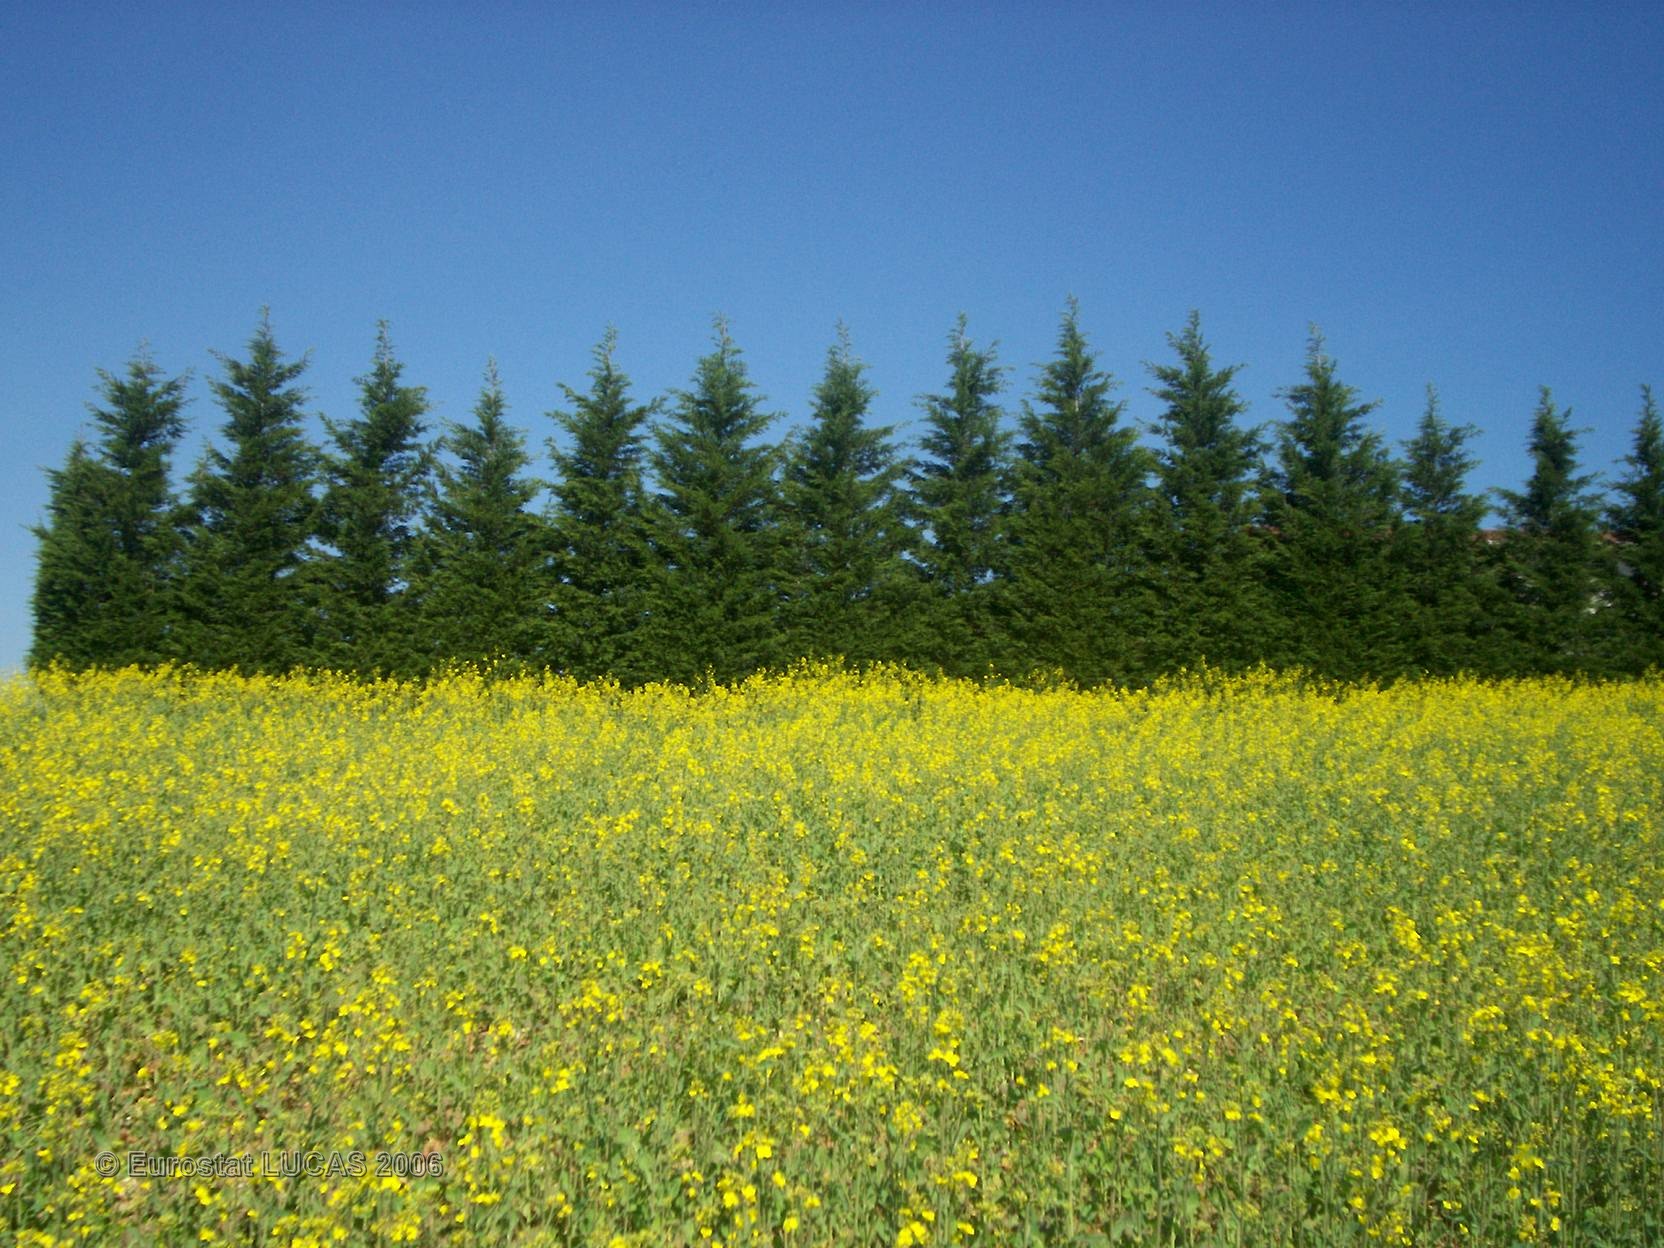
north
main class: Cropland
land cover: Rape and turnip rape
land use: Agriculture (excluding fallow land and kitchen gardens)
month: April
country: FR
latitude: 45.4473
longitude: 4.7749
